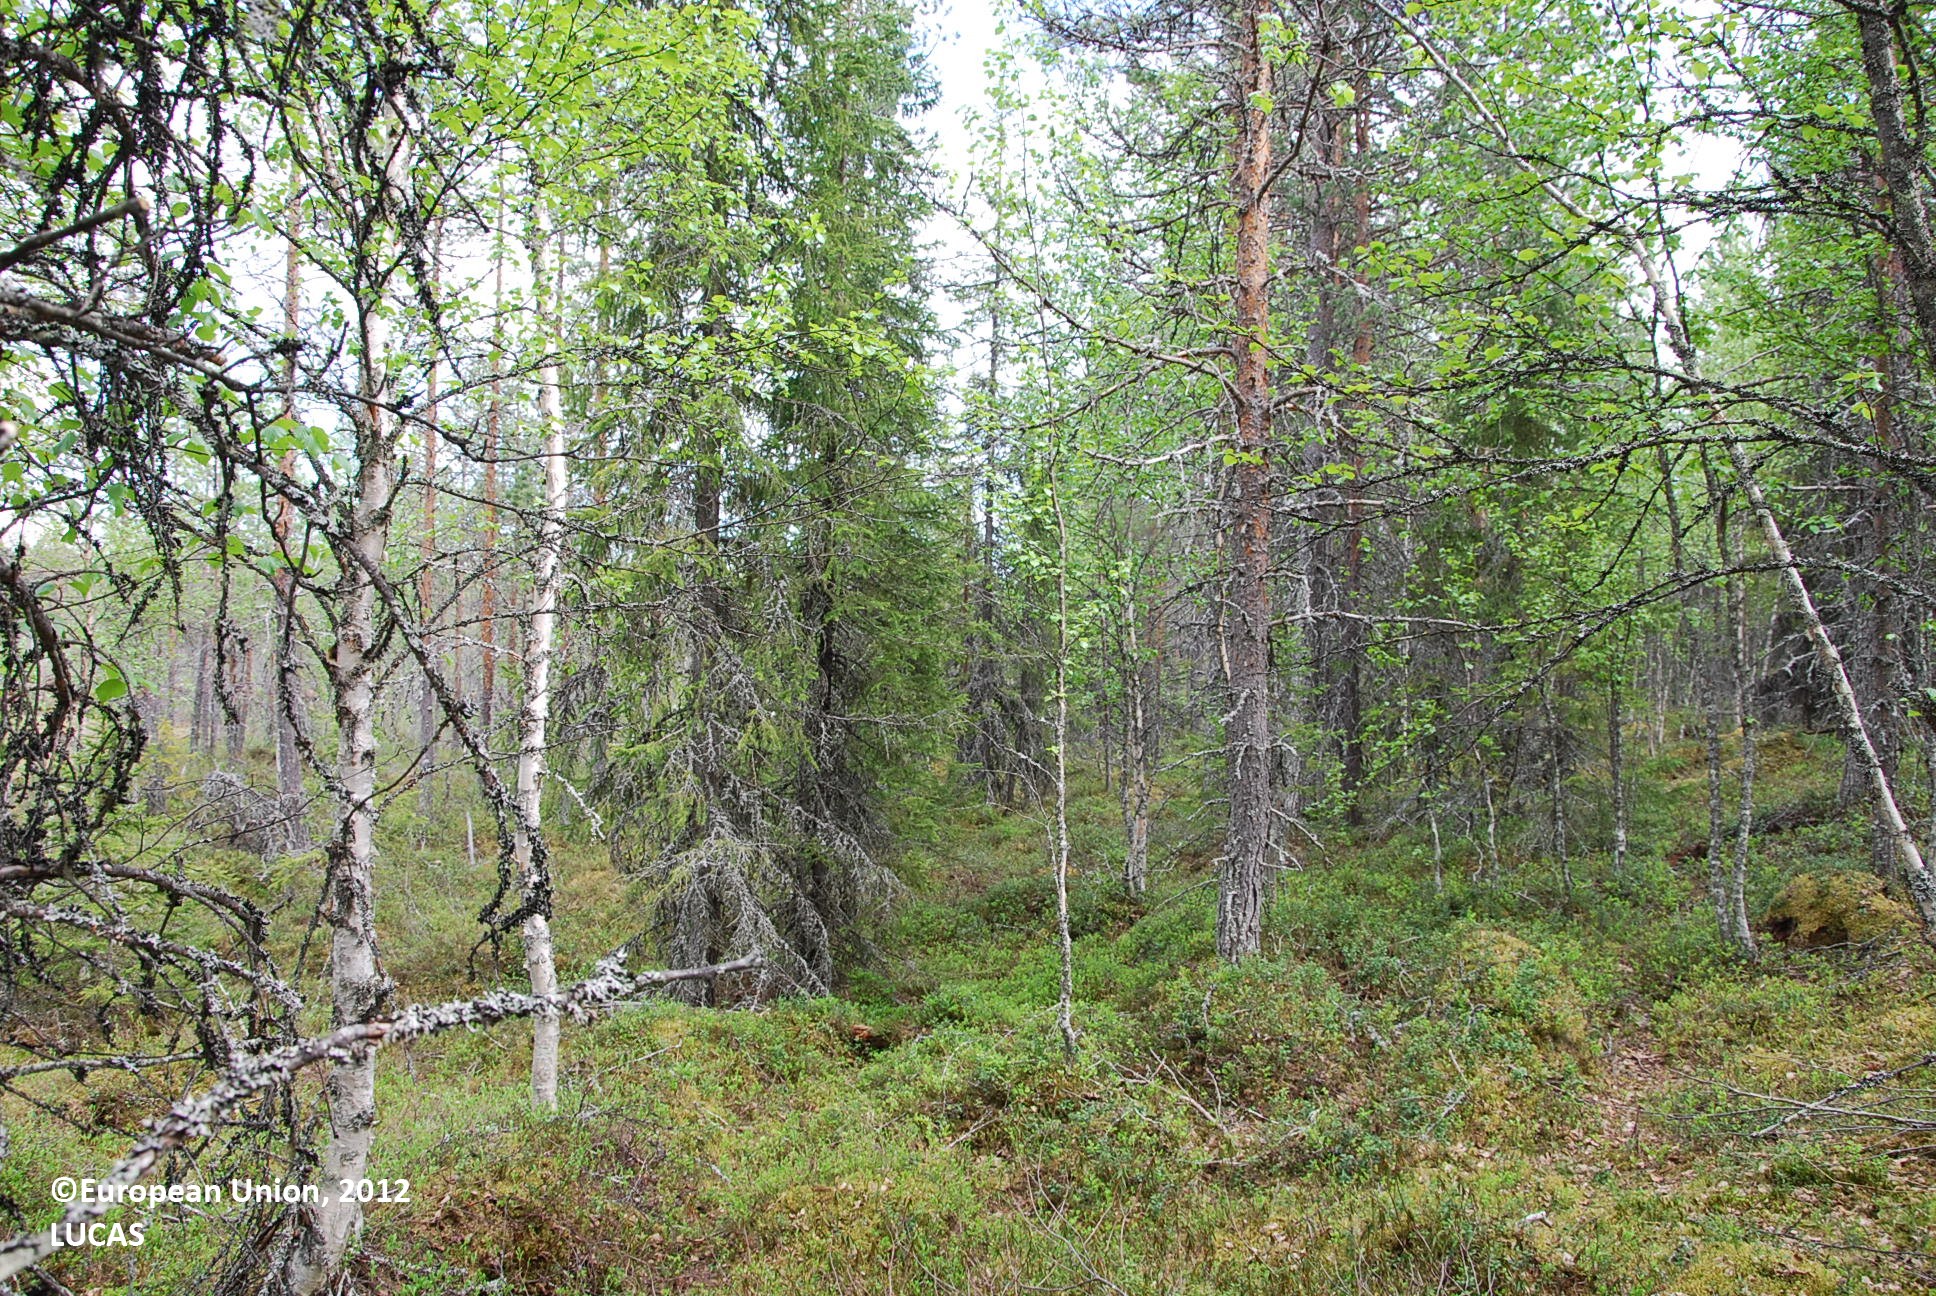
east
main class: Woodland
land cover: Pine dominated mixed woodland
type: boreal forest
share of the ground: > 75 %
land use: Forestry
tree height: > 5 m
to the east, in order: Pine dominated mixed woodland; Ditches and canals; Pine dominated coniferous woodland; Peatbogs; Ditches and canals; Pine dominated coniferous woodland; Ditches and canals; Pine dominated coniferous woodland; Broadleaved woodland; Grassland with sparse tree/shrub cover
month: June
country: FI
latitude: 66.0406
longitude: 27.6708
